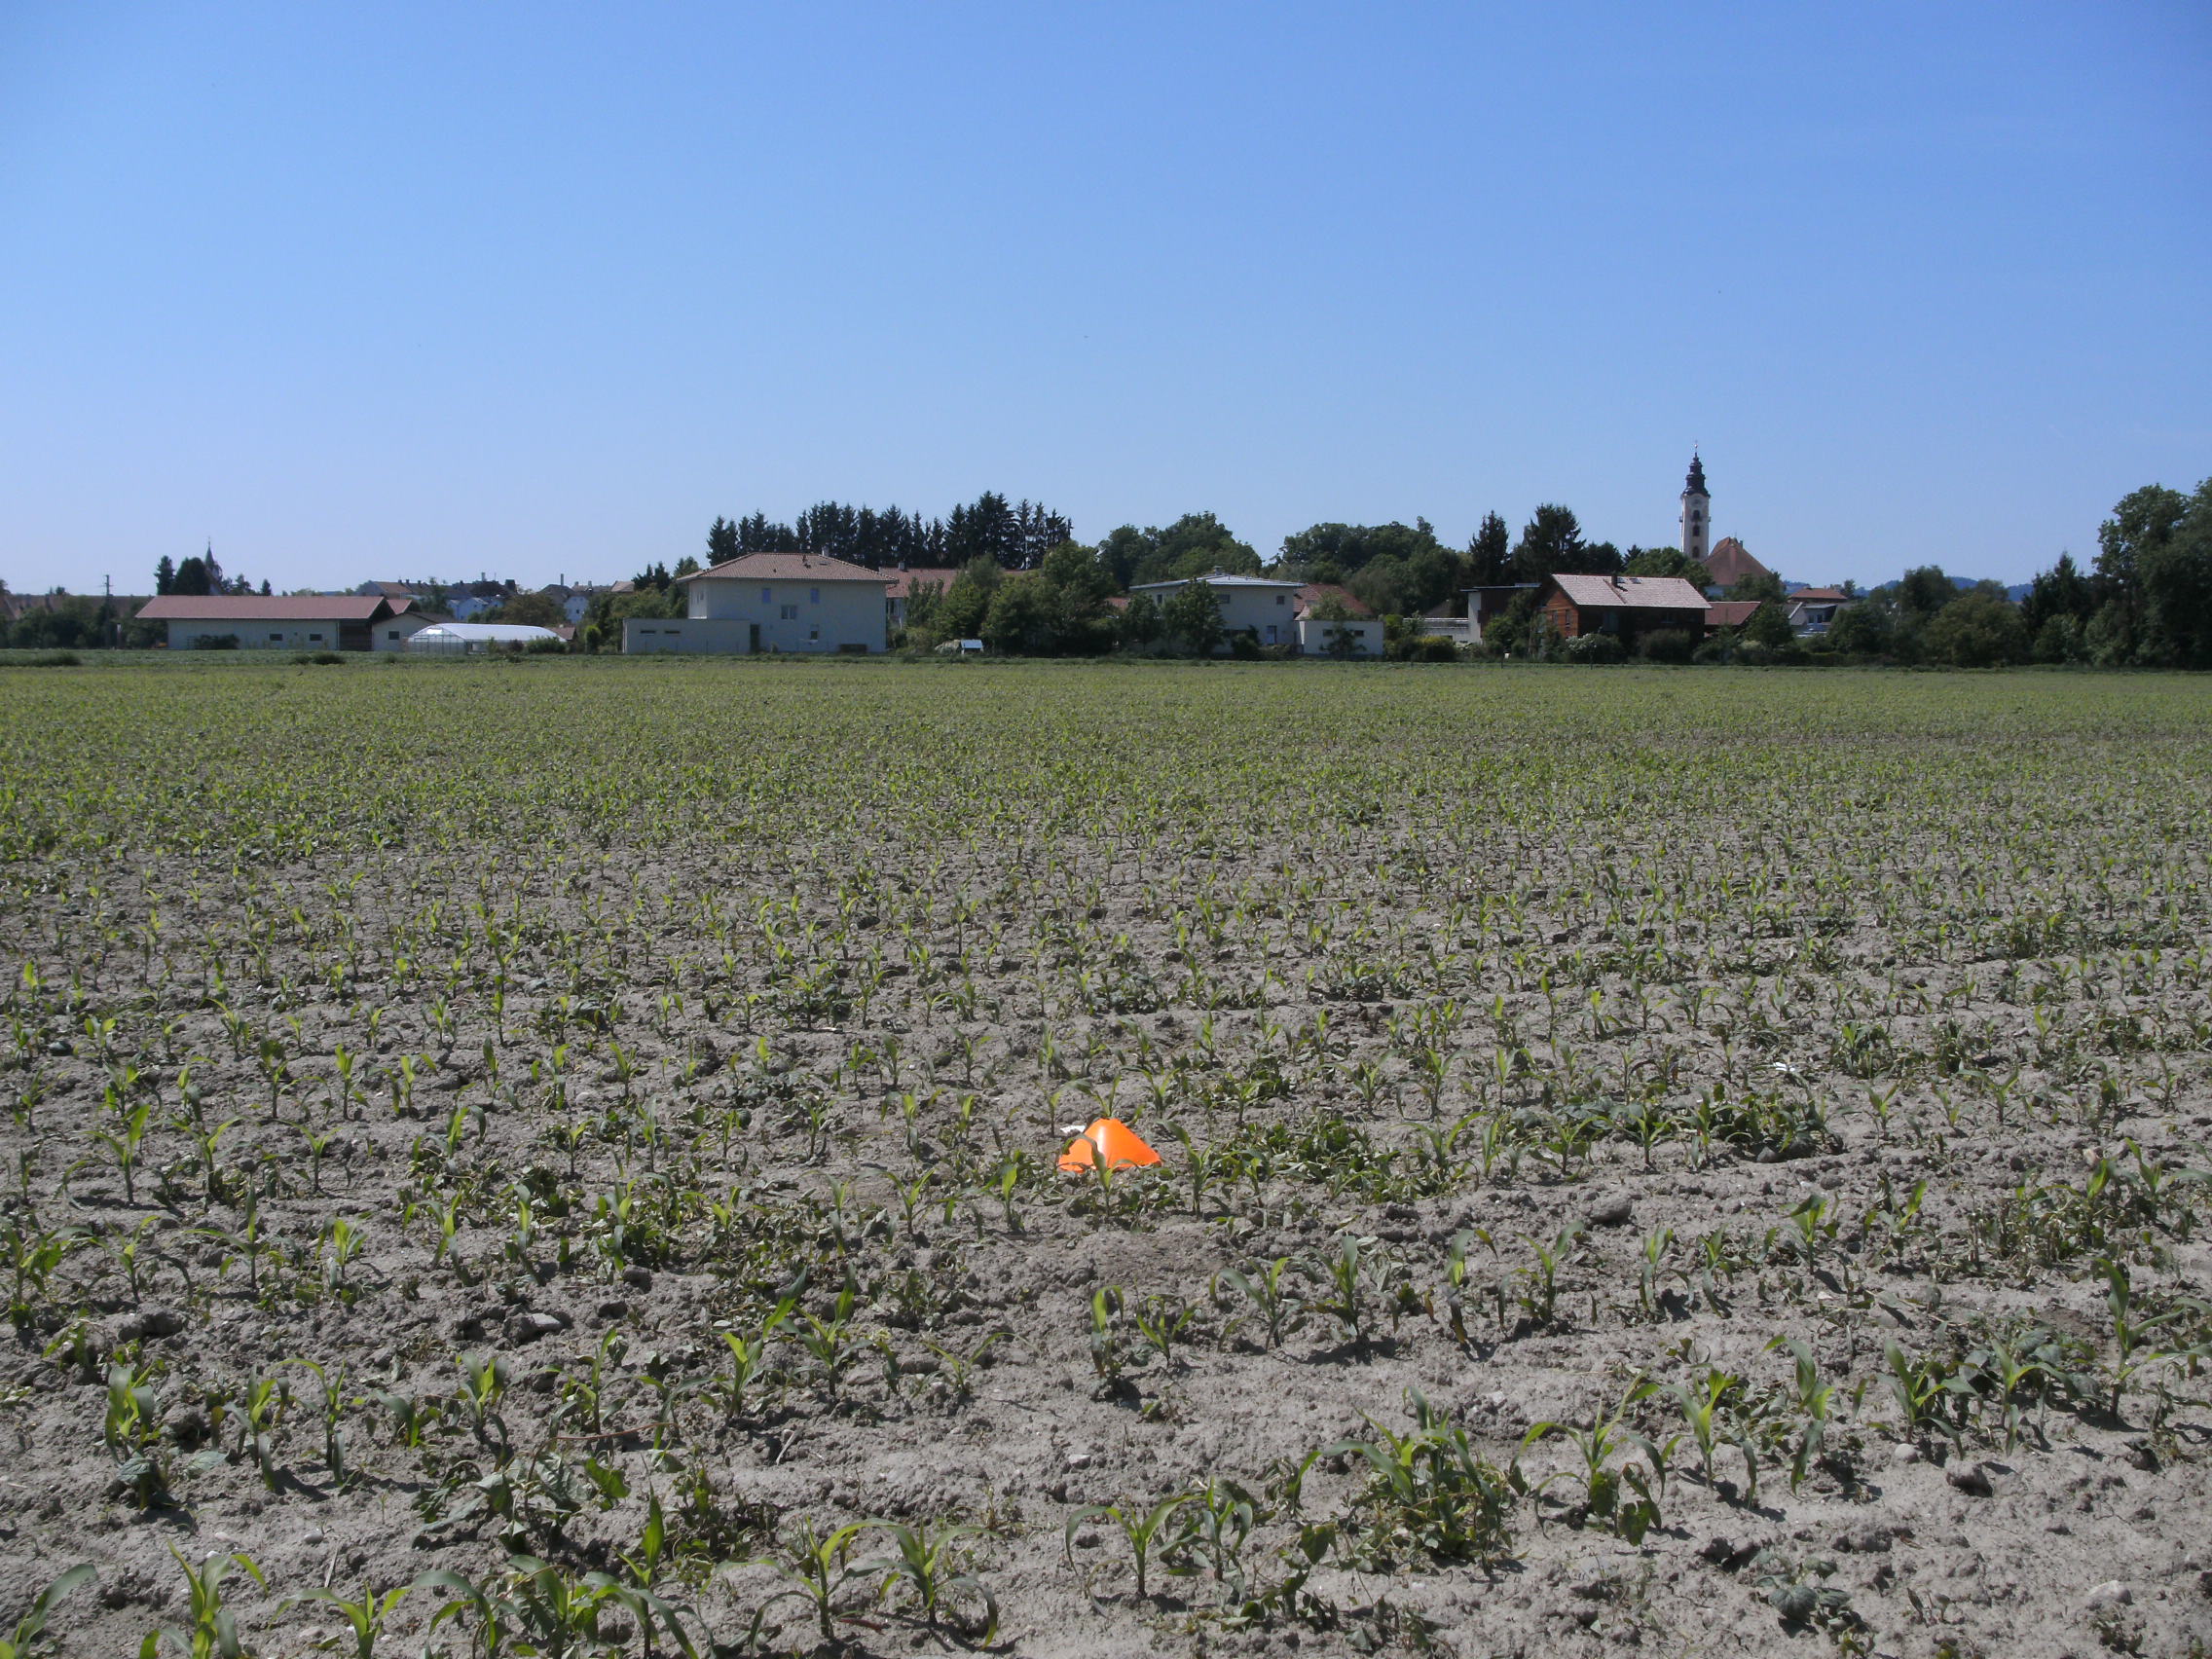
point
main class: Cropland
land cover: Maize
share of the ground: 10 - 25 %
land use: Agriculture (excluding fallow land and kitchen gardens)
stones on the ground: < 10 %
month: May
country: AT
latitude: 48.3120
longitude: 14.0315
